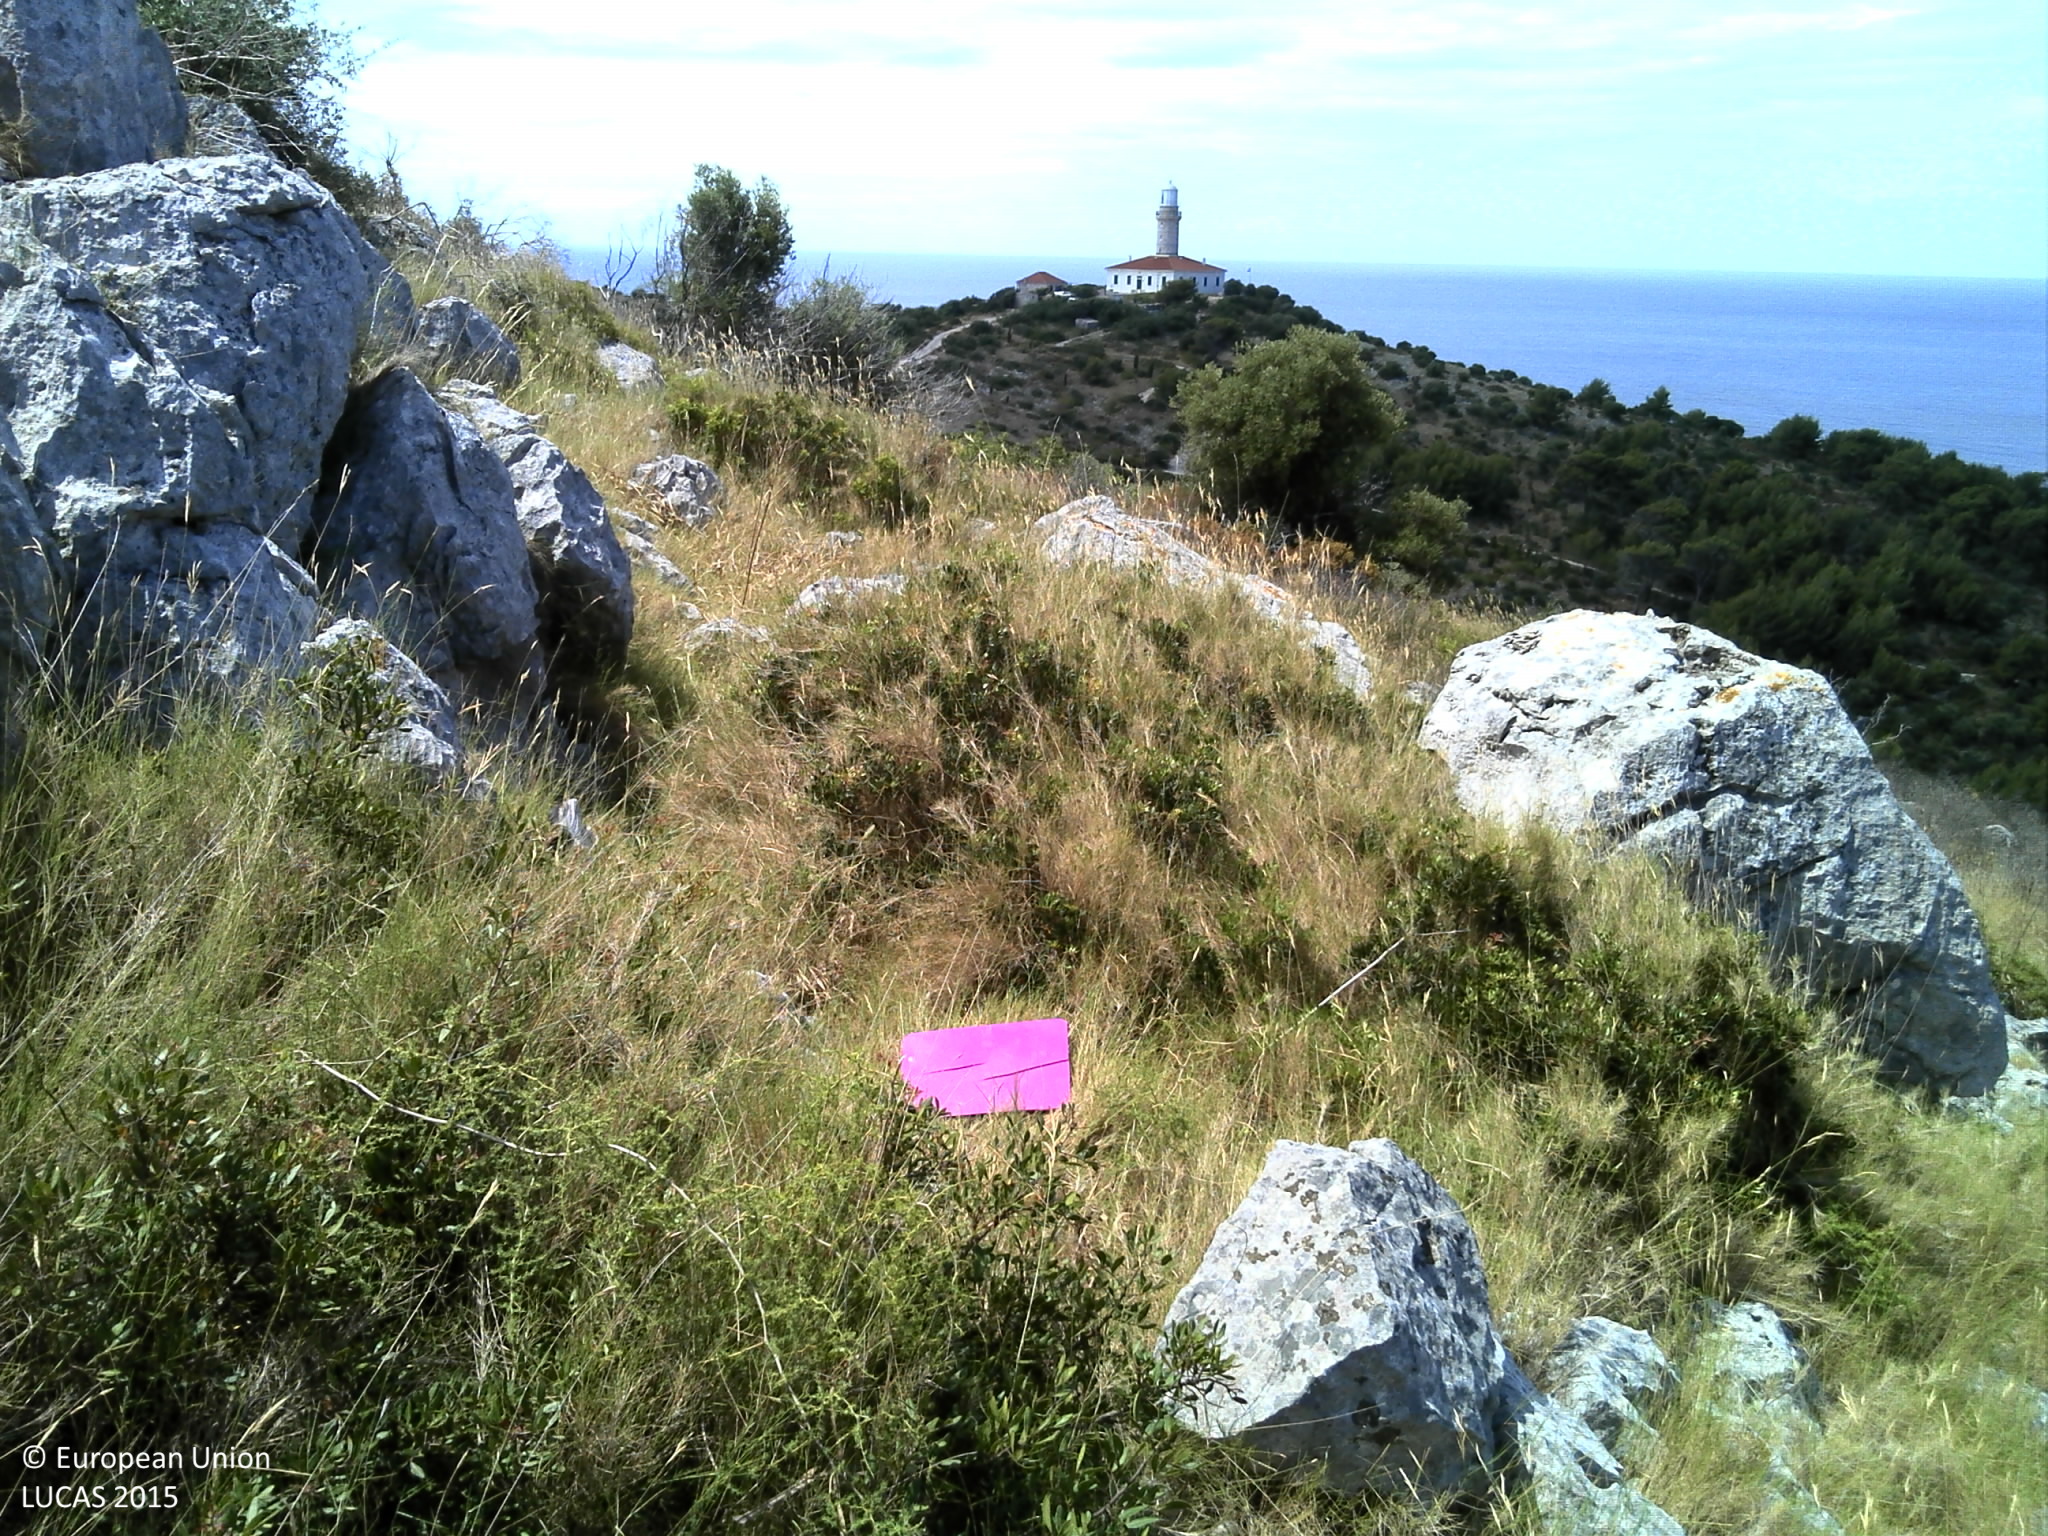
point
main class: Shrubland
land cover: Shrubland without tree cover
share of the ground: 10 - 25 %
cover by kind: herbaceous plants 30 %, unconsolidated bare surface 30 %, shrubs 20 %, consolidated bare surface 15 %, lichens and mosses 5 %
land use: Semi-natural and natural areas not in use
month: June
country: HR
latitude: 42.7274
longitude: 16.8882
